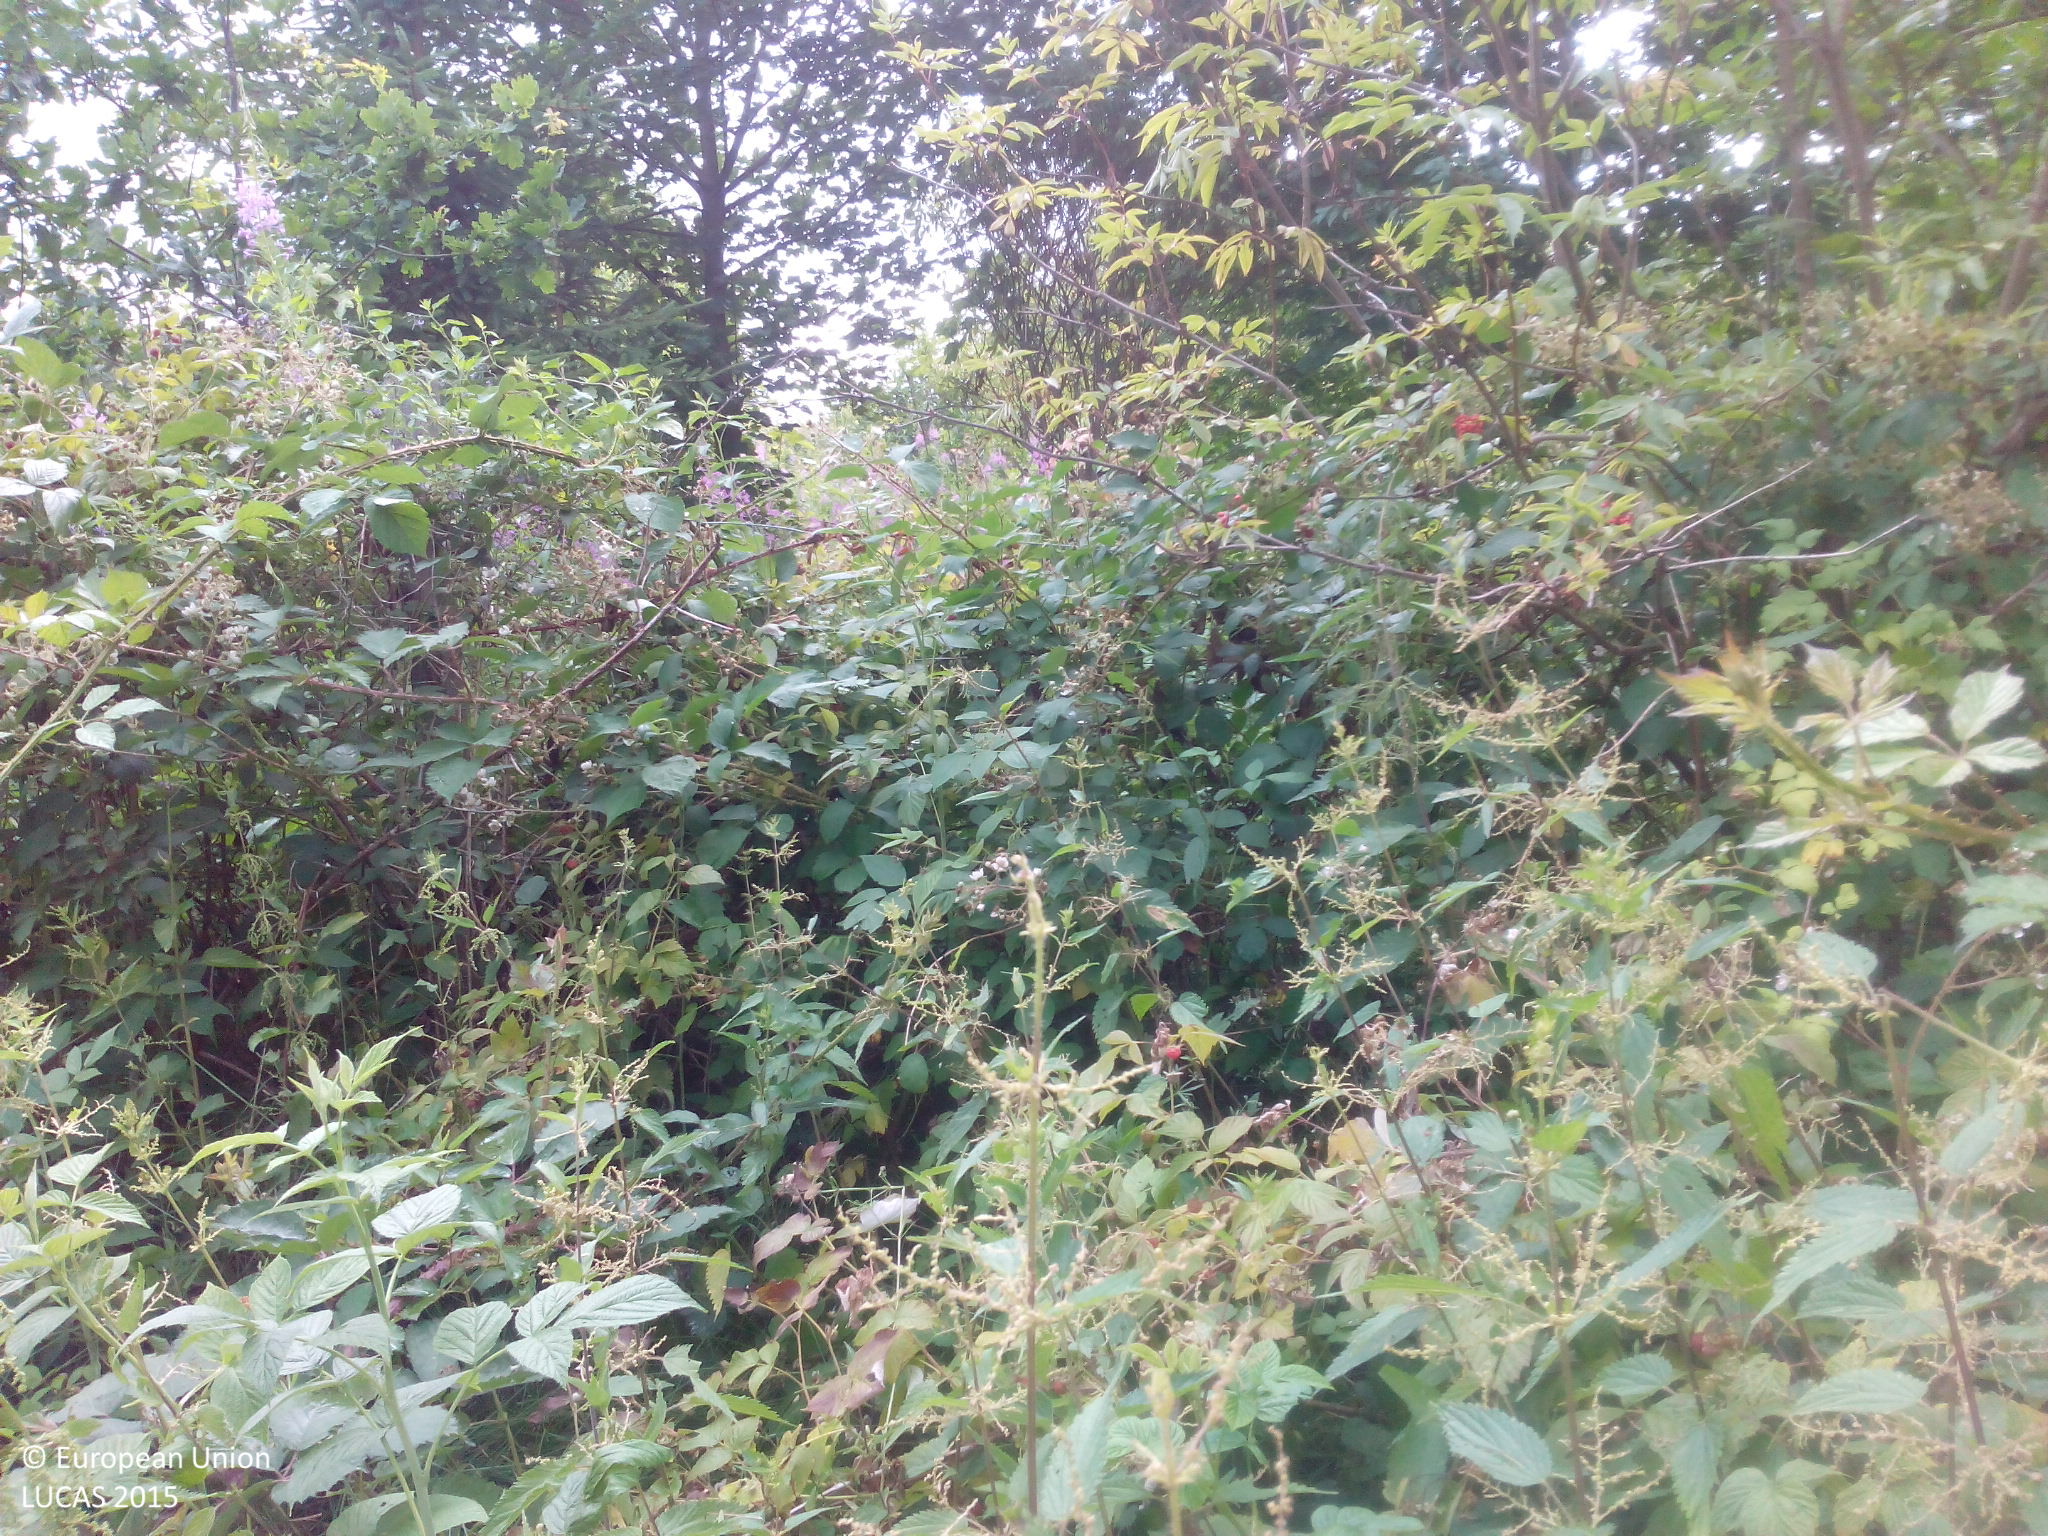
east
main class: Woodland
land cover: Broadleaved woodland
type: mesophytic deciduous forest
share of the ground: 50 - 75 %
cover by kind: broadleaved forest trees 60 %, herbaceous plants 20 %, coniferous forest trees 10 %, lichens and mosses 5 %, unconsolidated bare surface 5 %
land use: Forestry
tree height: > 5 m
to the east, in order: Shruby margins; Fences; Broadleaved woodland
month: July
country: DE
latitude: 48.8614
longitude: 11.4852
